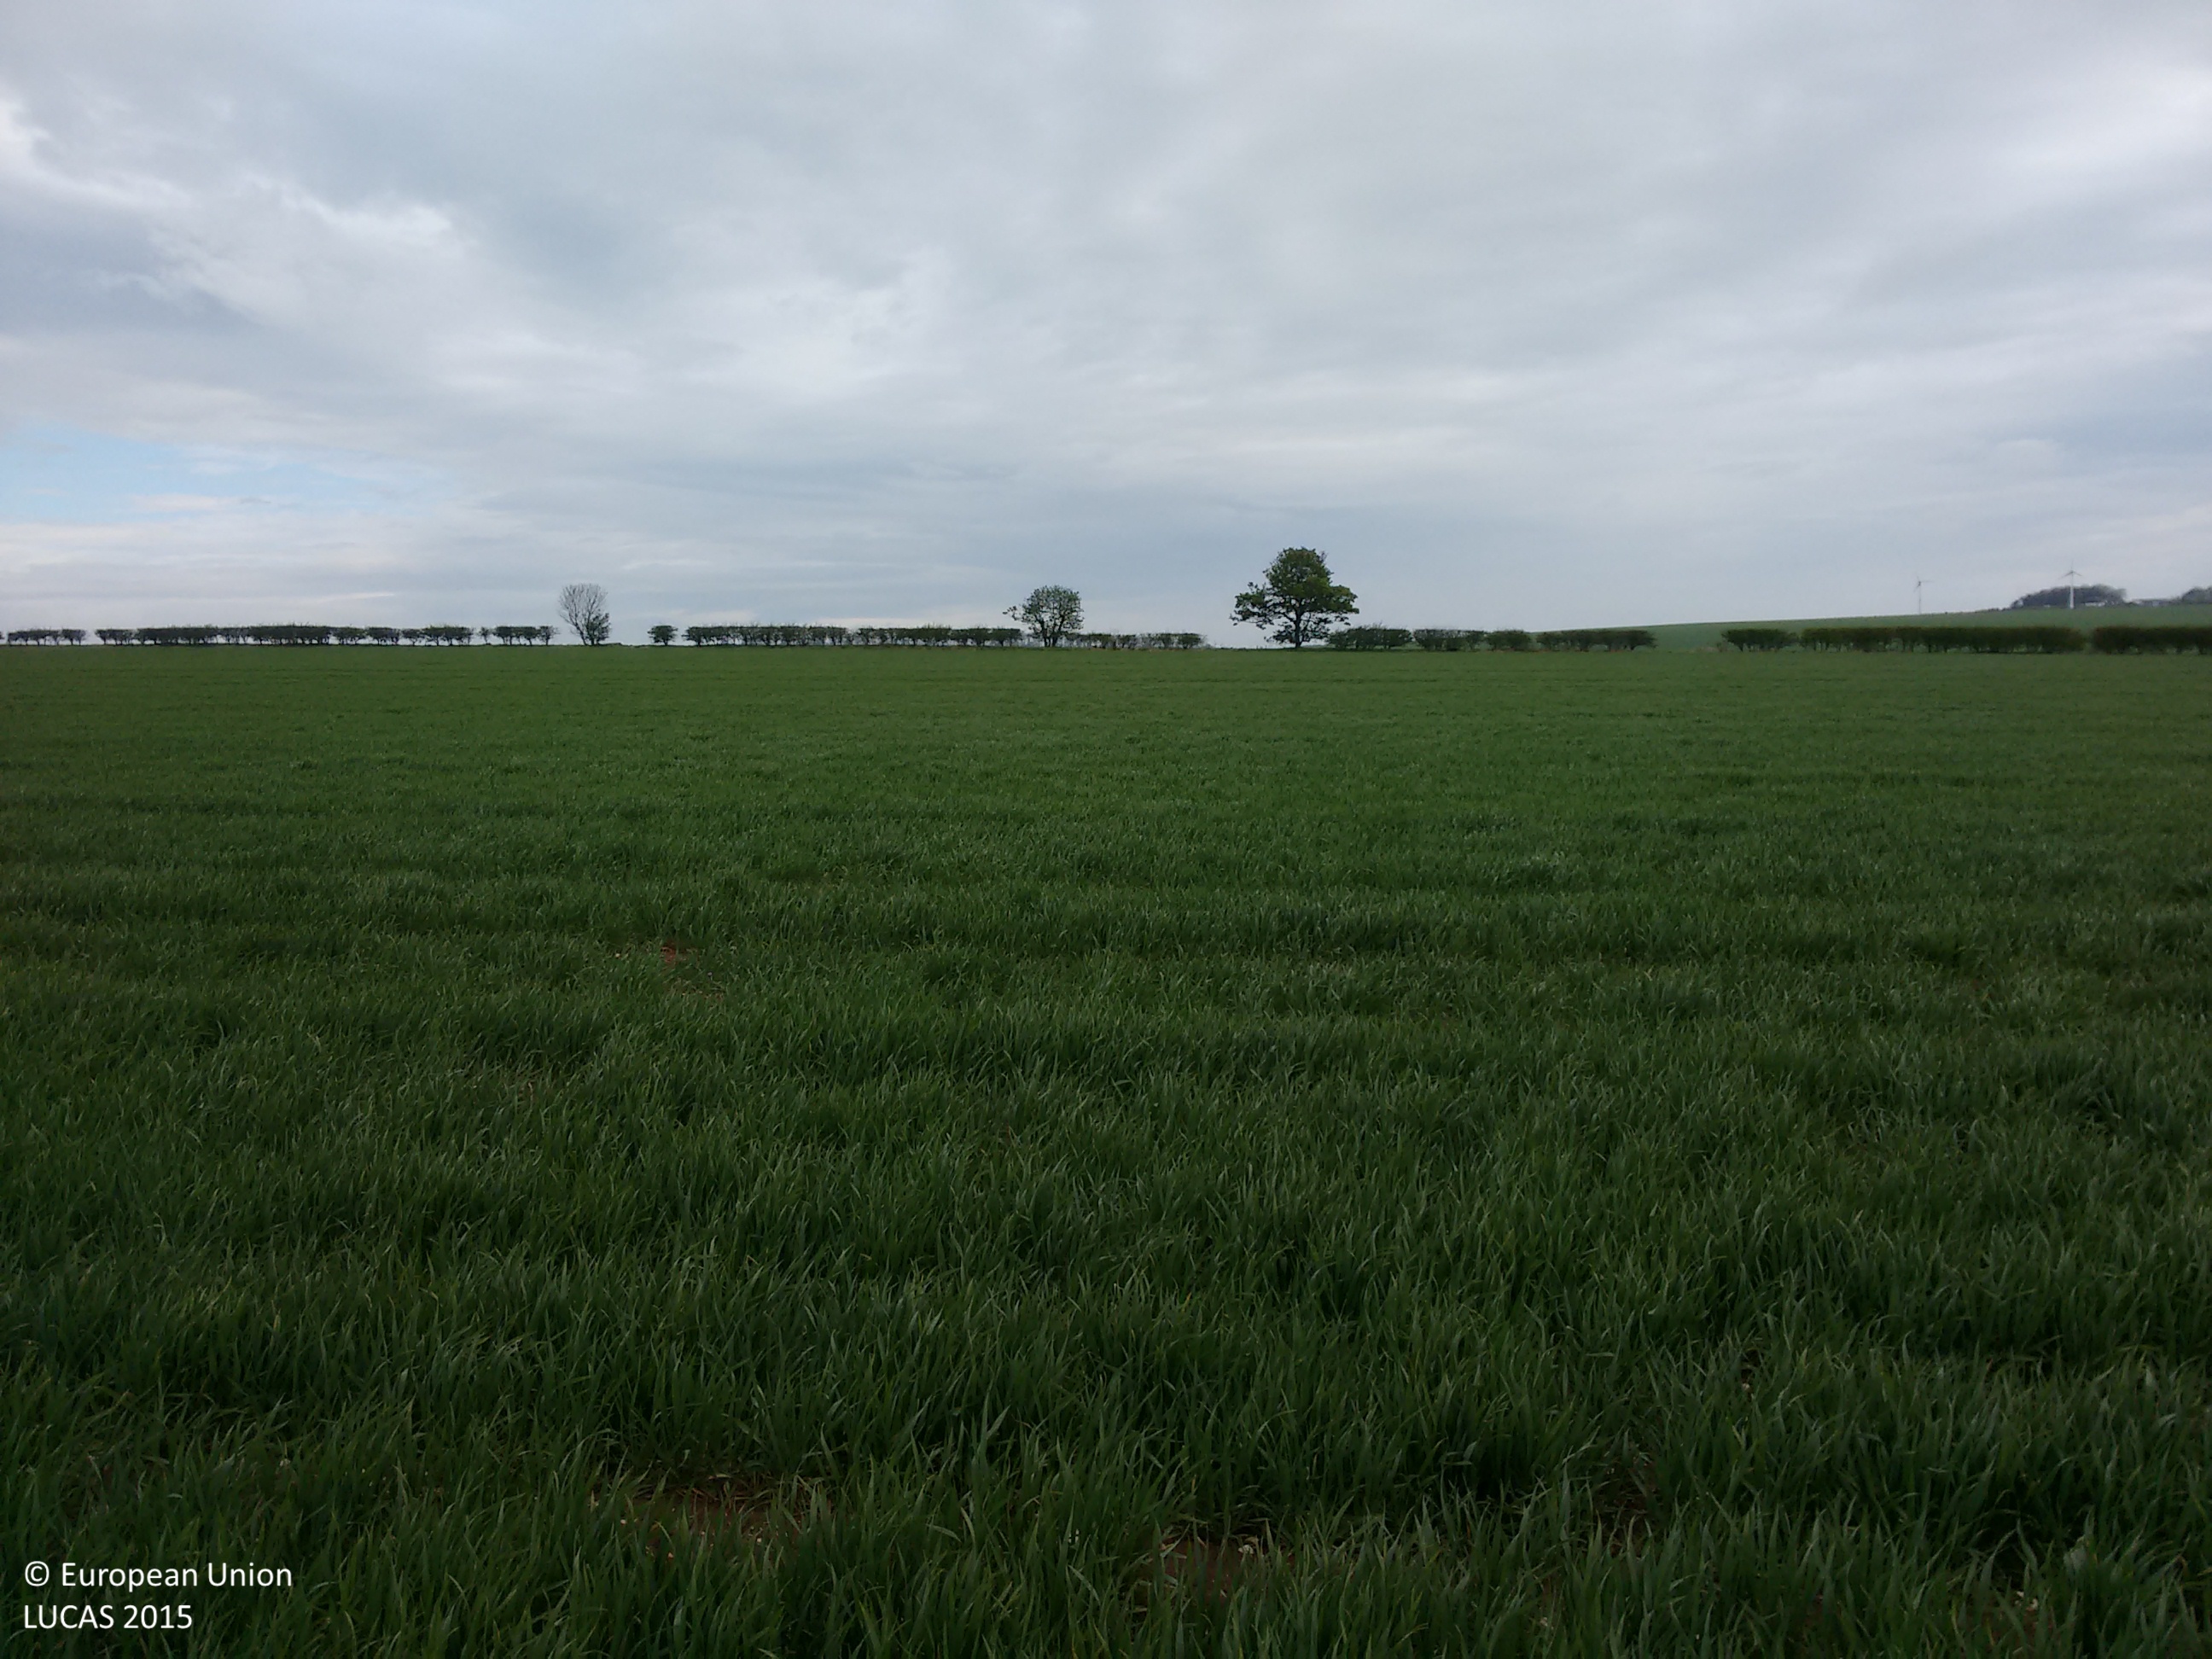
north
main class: Cropland
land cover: Common wheat
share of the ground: > 75 %
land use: Agriculture (excluding fallow land and kitchen gardens)
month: May
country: GB
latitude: 54.1523
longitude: -0.3701
